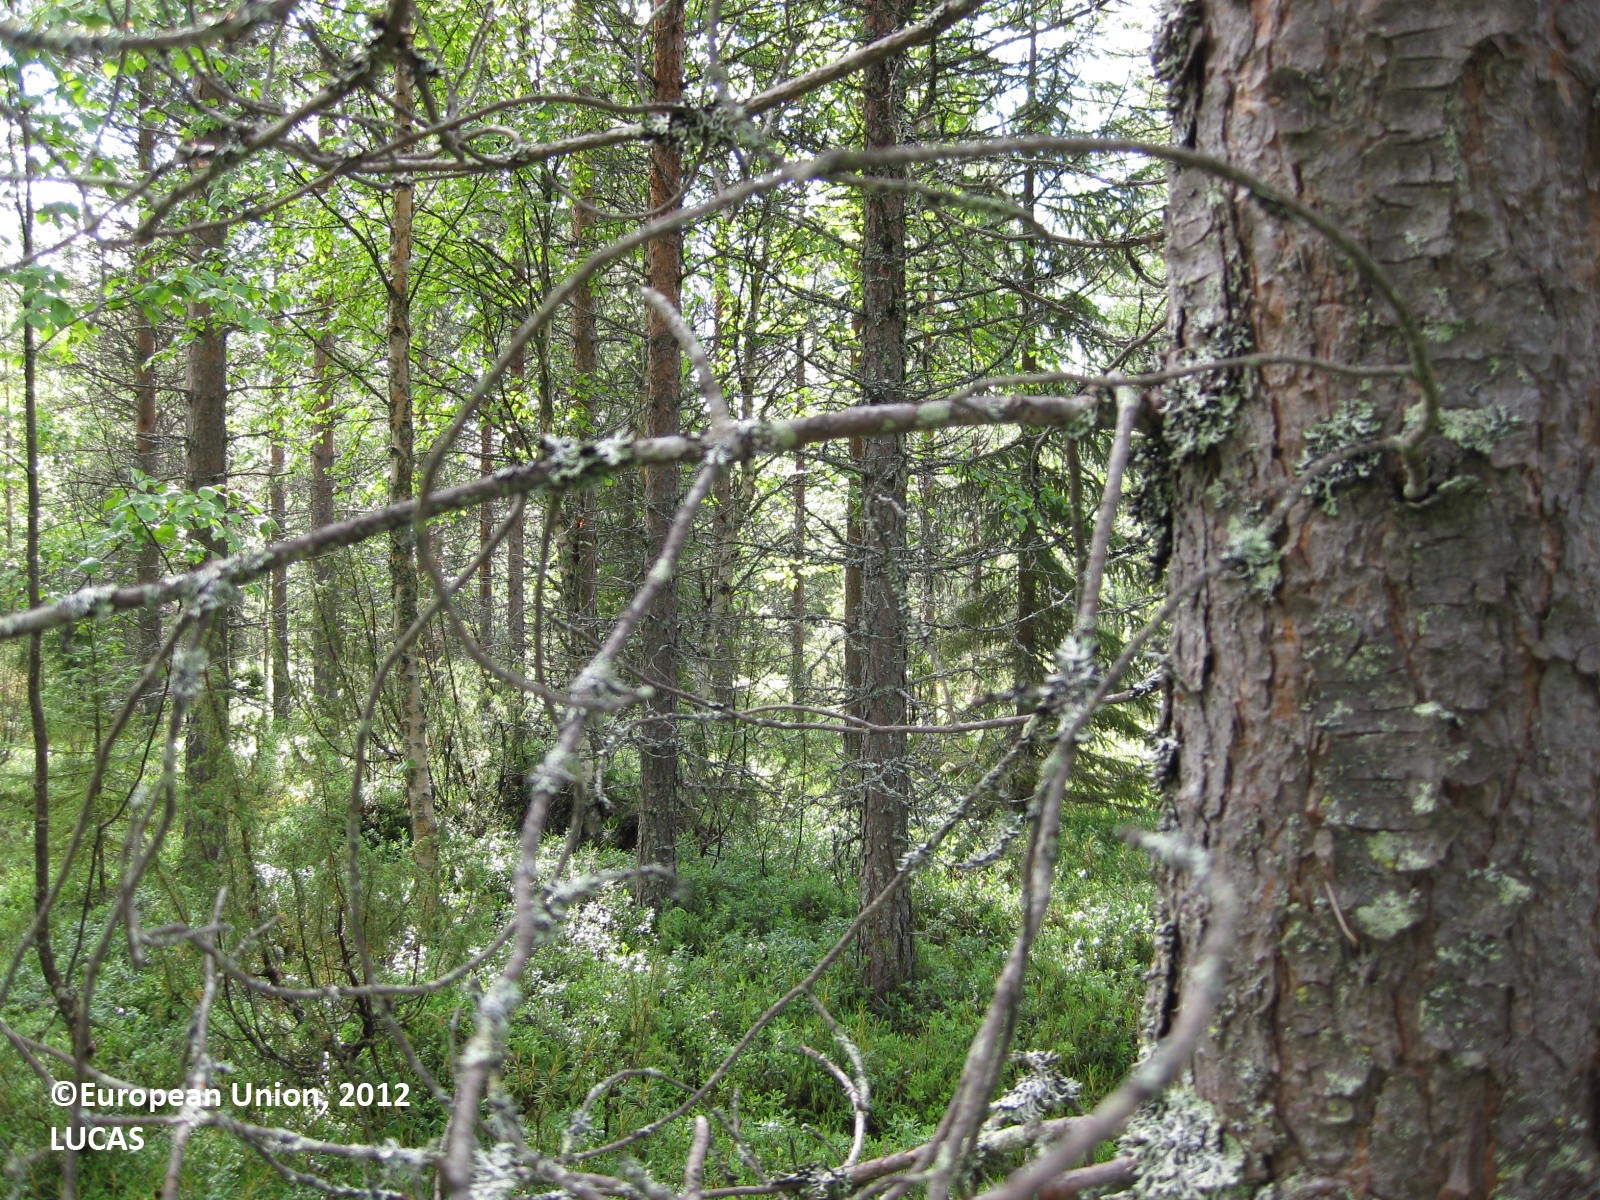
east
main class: Woodland
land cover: Pine dominated mixed woodland
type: boreal forest
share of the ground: > 75 %
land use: Forestry
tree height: > 5 m
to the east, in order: Pine dominated mixed woodland; Abandoned hedges; Ditches and canals; Pine dominated mixed woodland; Ditches and canals; Shrubland with sparse tree cover; Ditches and canals; Pine dominated coniferous woodland; Ditches and canals; Pine dominated coniferous woodland; Ditches and canals; Pine dominated coniferous woodland; Ditches and canals; Pine dominated coniferous woodland; Ditches and canals; Pine dominated coniferous woodland; Ditches and canals; Pine dominated coniferous woodland; Ditches and canals; Pine dominated coniferous woodland; Ditches and canals; Pine dominated coniferous woodland; Ditches and canals; Pine dominated coniferous woodland; Ditches and canals; Pine dominated coniferous woodland; Ditches and canals; Pine dominated coniferous woodland; Shrubland without tree cover; Pine dominated coniferous woodland; Ditches and canals; Pine dominated coniferous woodland; Ditches and canals; Pine dominated coniferous woodland; Ditches and canals; Pine dominated coniferous woodland; Ditches and canals; Pine dominated coniferous woodland; Ditches and canals; Pine dominated coniferous woodland; Ditches and canals; Pine dominated coniferous woodland; Ditches and canals; Pine dominated coniferous woodland; Ditches and canals; Pine dominated coniferous woodland; Ditches and canals; Pine dominated coniferous woodland; Ditches and canals; Pine dominated coniferous woodland; Ditches and canals; Pine dominated coniferous woodland; Ditches and canals; Pine dominated coniferous woodland
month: July
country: FI
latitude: 65.6924
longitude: 29.4163
